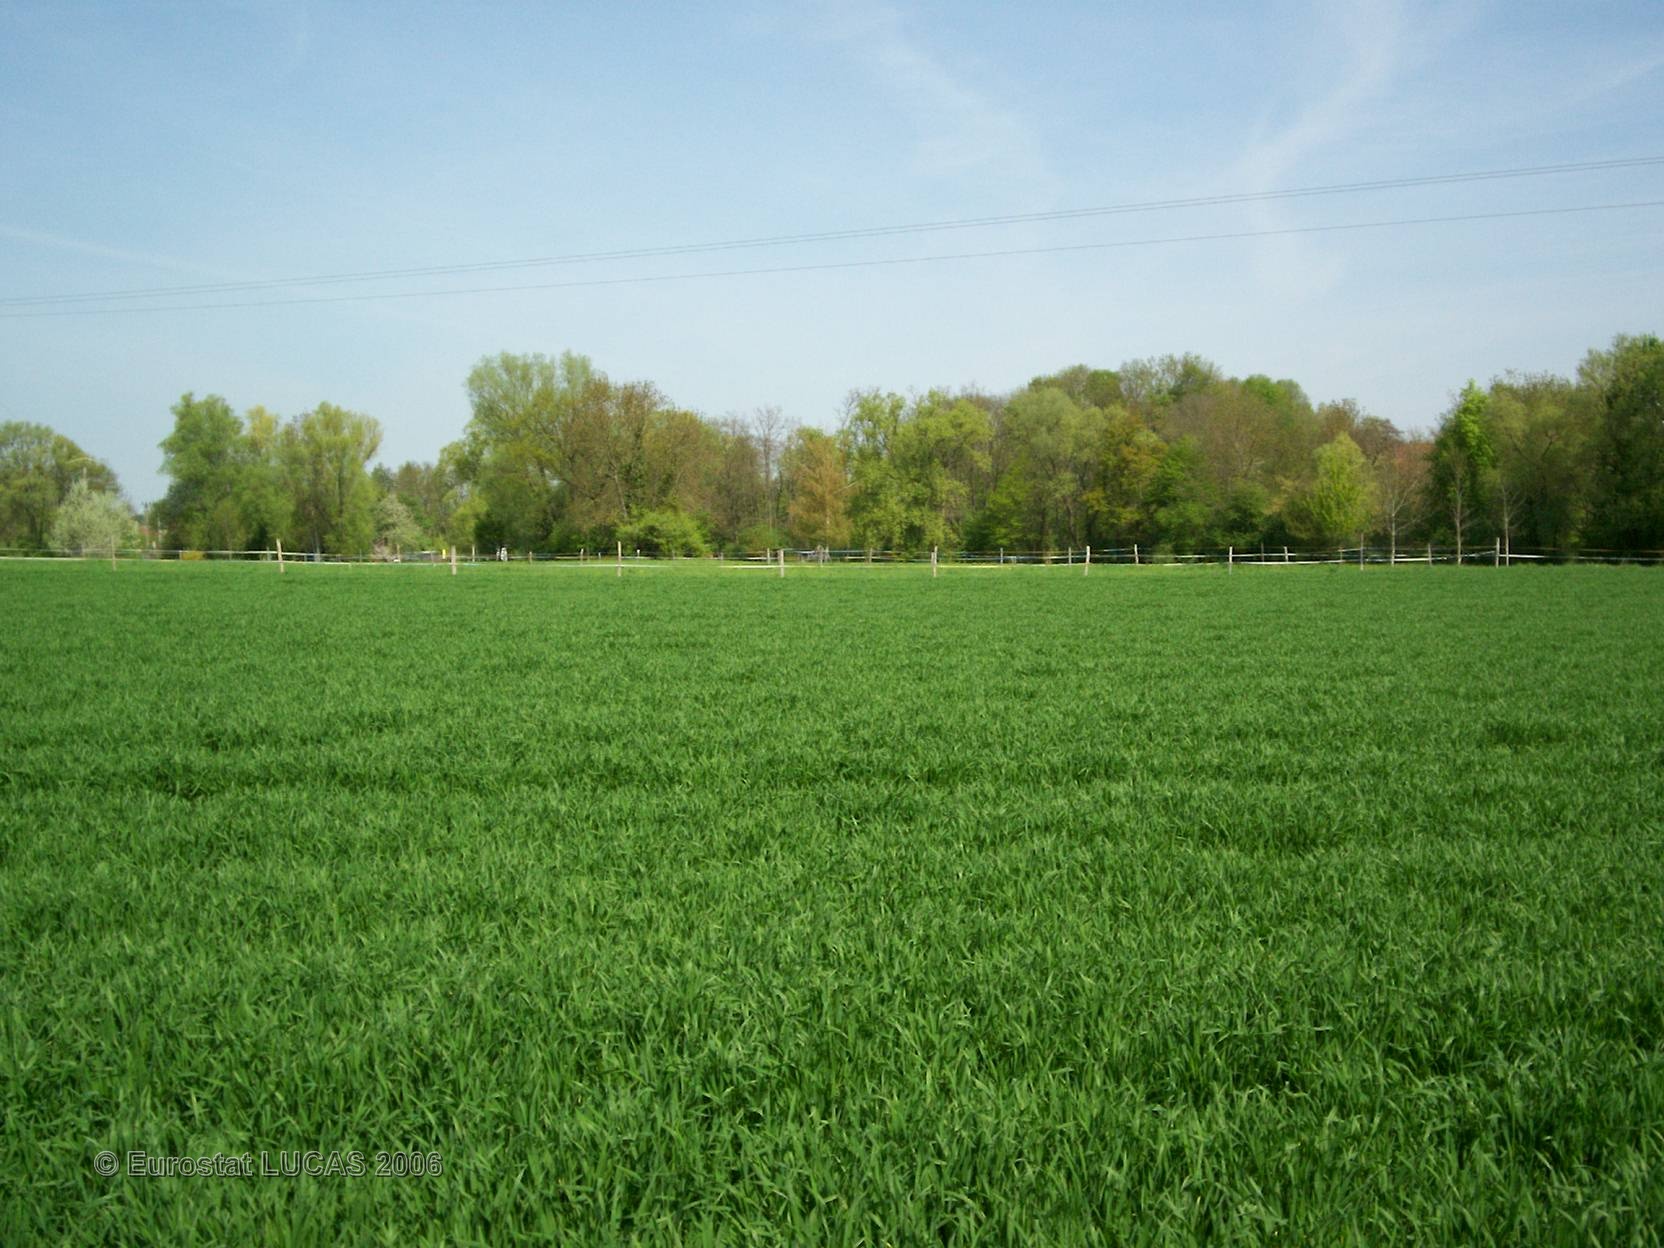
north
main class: Cropland
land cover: Common wheat
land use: Agriculture (excluding fallow land and kitchen gardens)
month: May
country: FR
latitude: 47.6535
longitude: 7.4319
